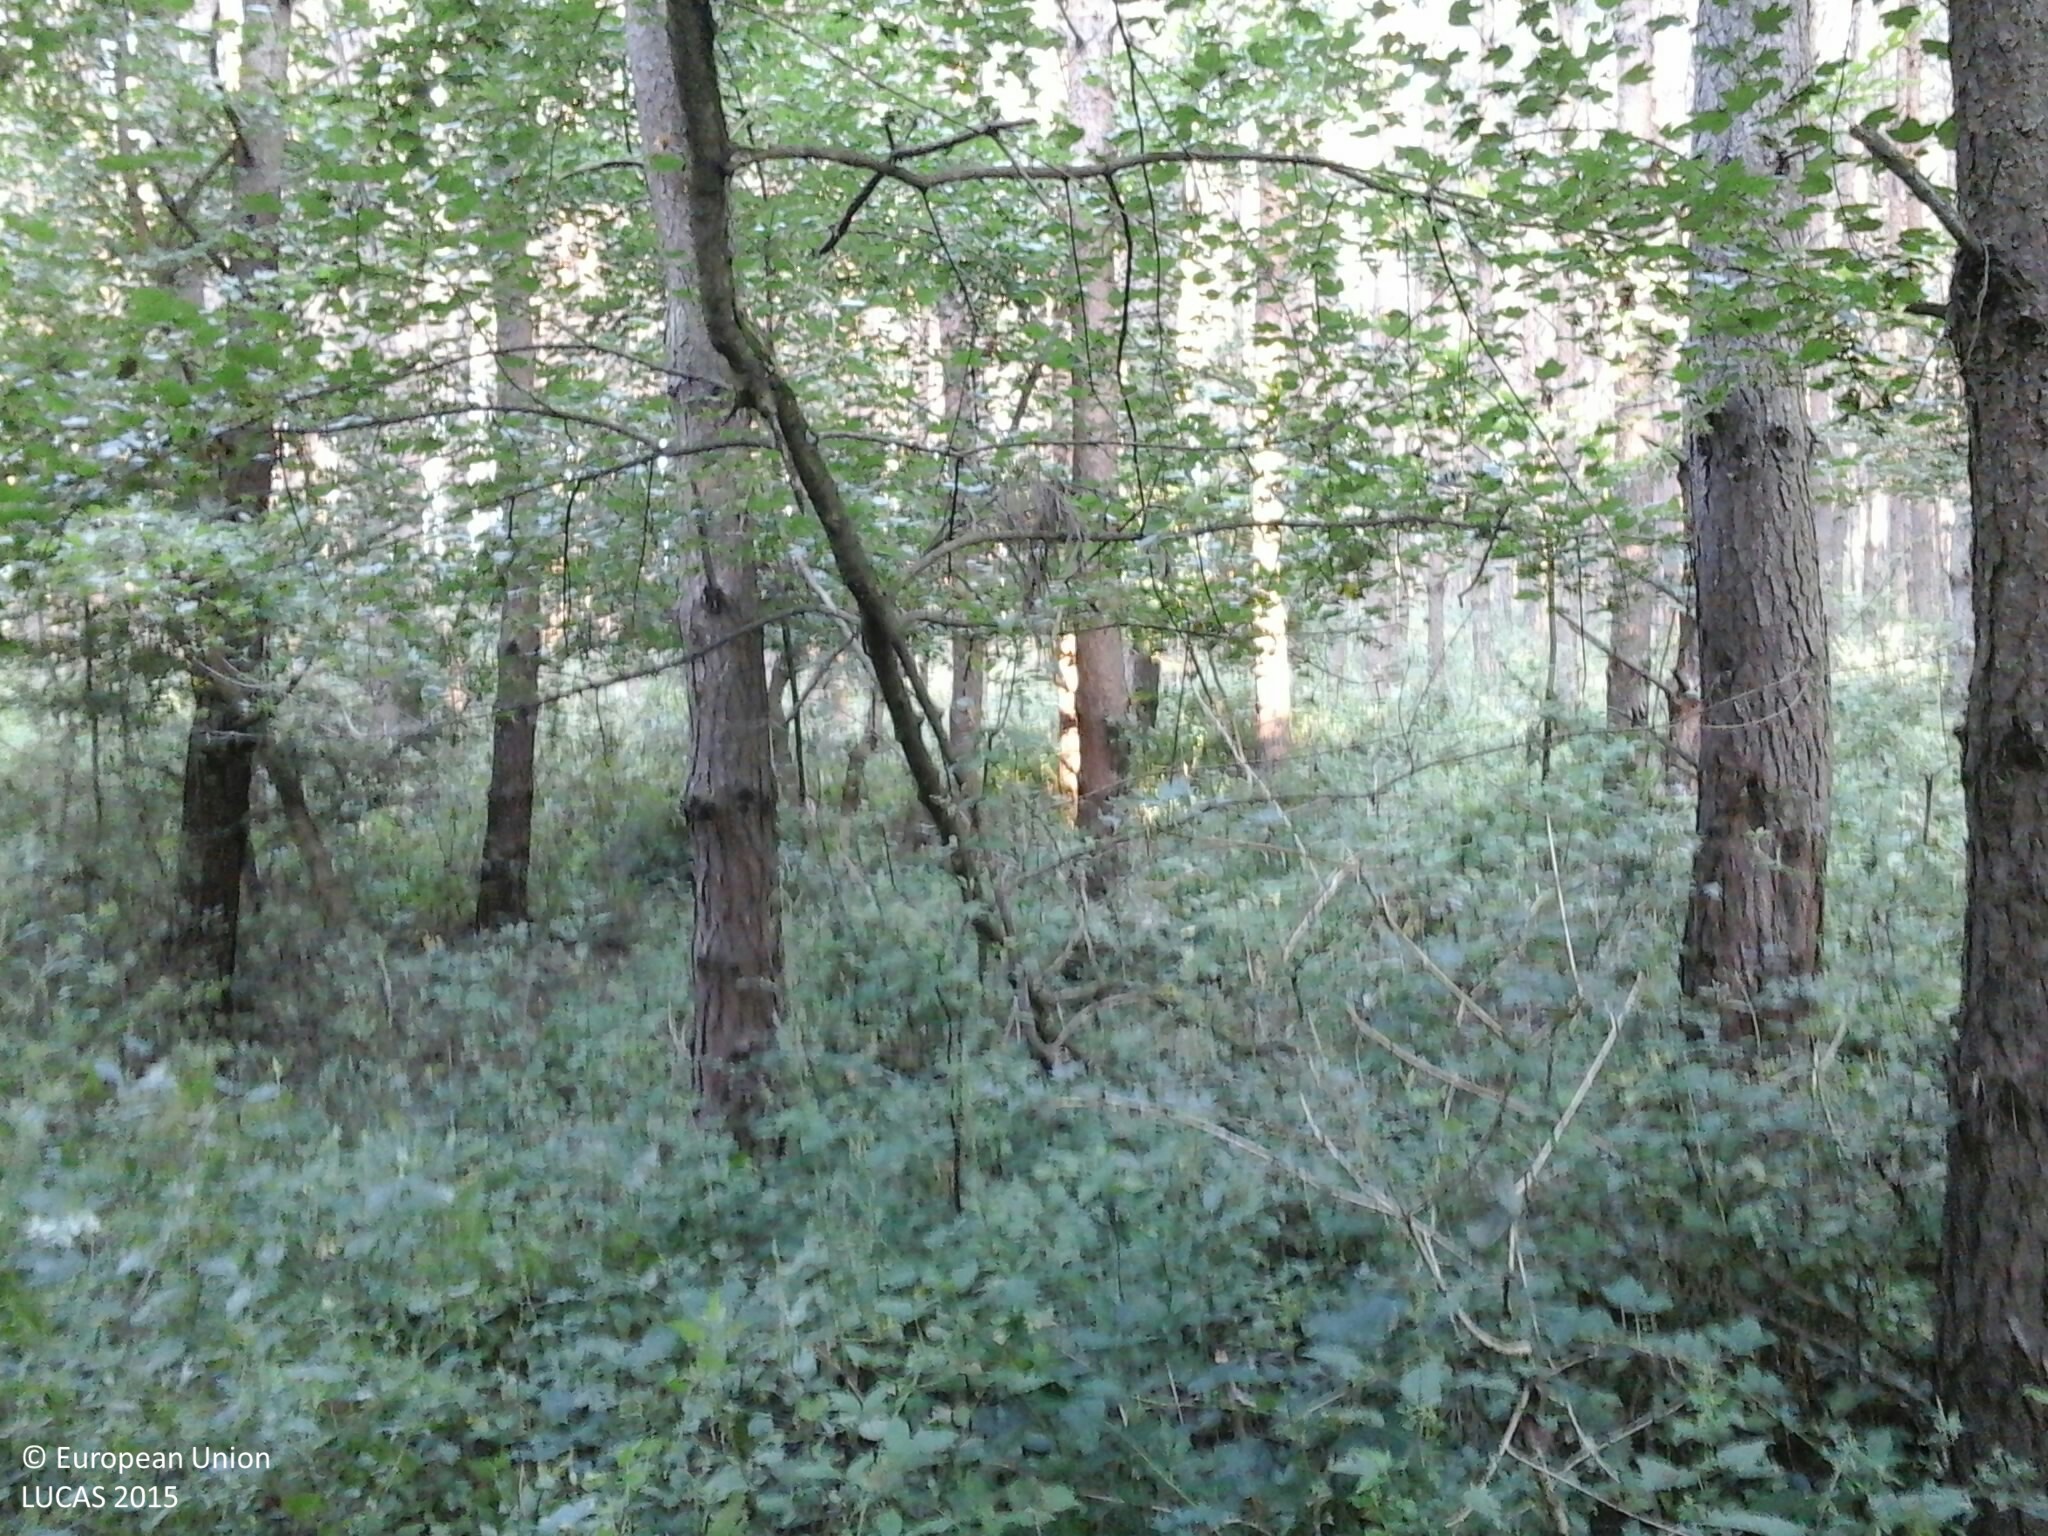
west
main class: Woodland
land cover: Pine dominated mixed woodland
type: hemiboreal forest and nemoral coniferous forest and mixed broadleaved-coniferous forest
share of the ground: > 75 %
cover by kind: coniferous forest trees 60 %, broadleaved forest trees 20 %, shrubs 15 %, herbaceous plants 5 %
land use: Forestry
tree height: > 5 m
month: August
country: HU
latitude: 47.1662
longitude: 16.4802
